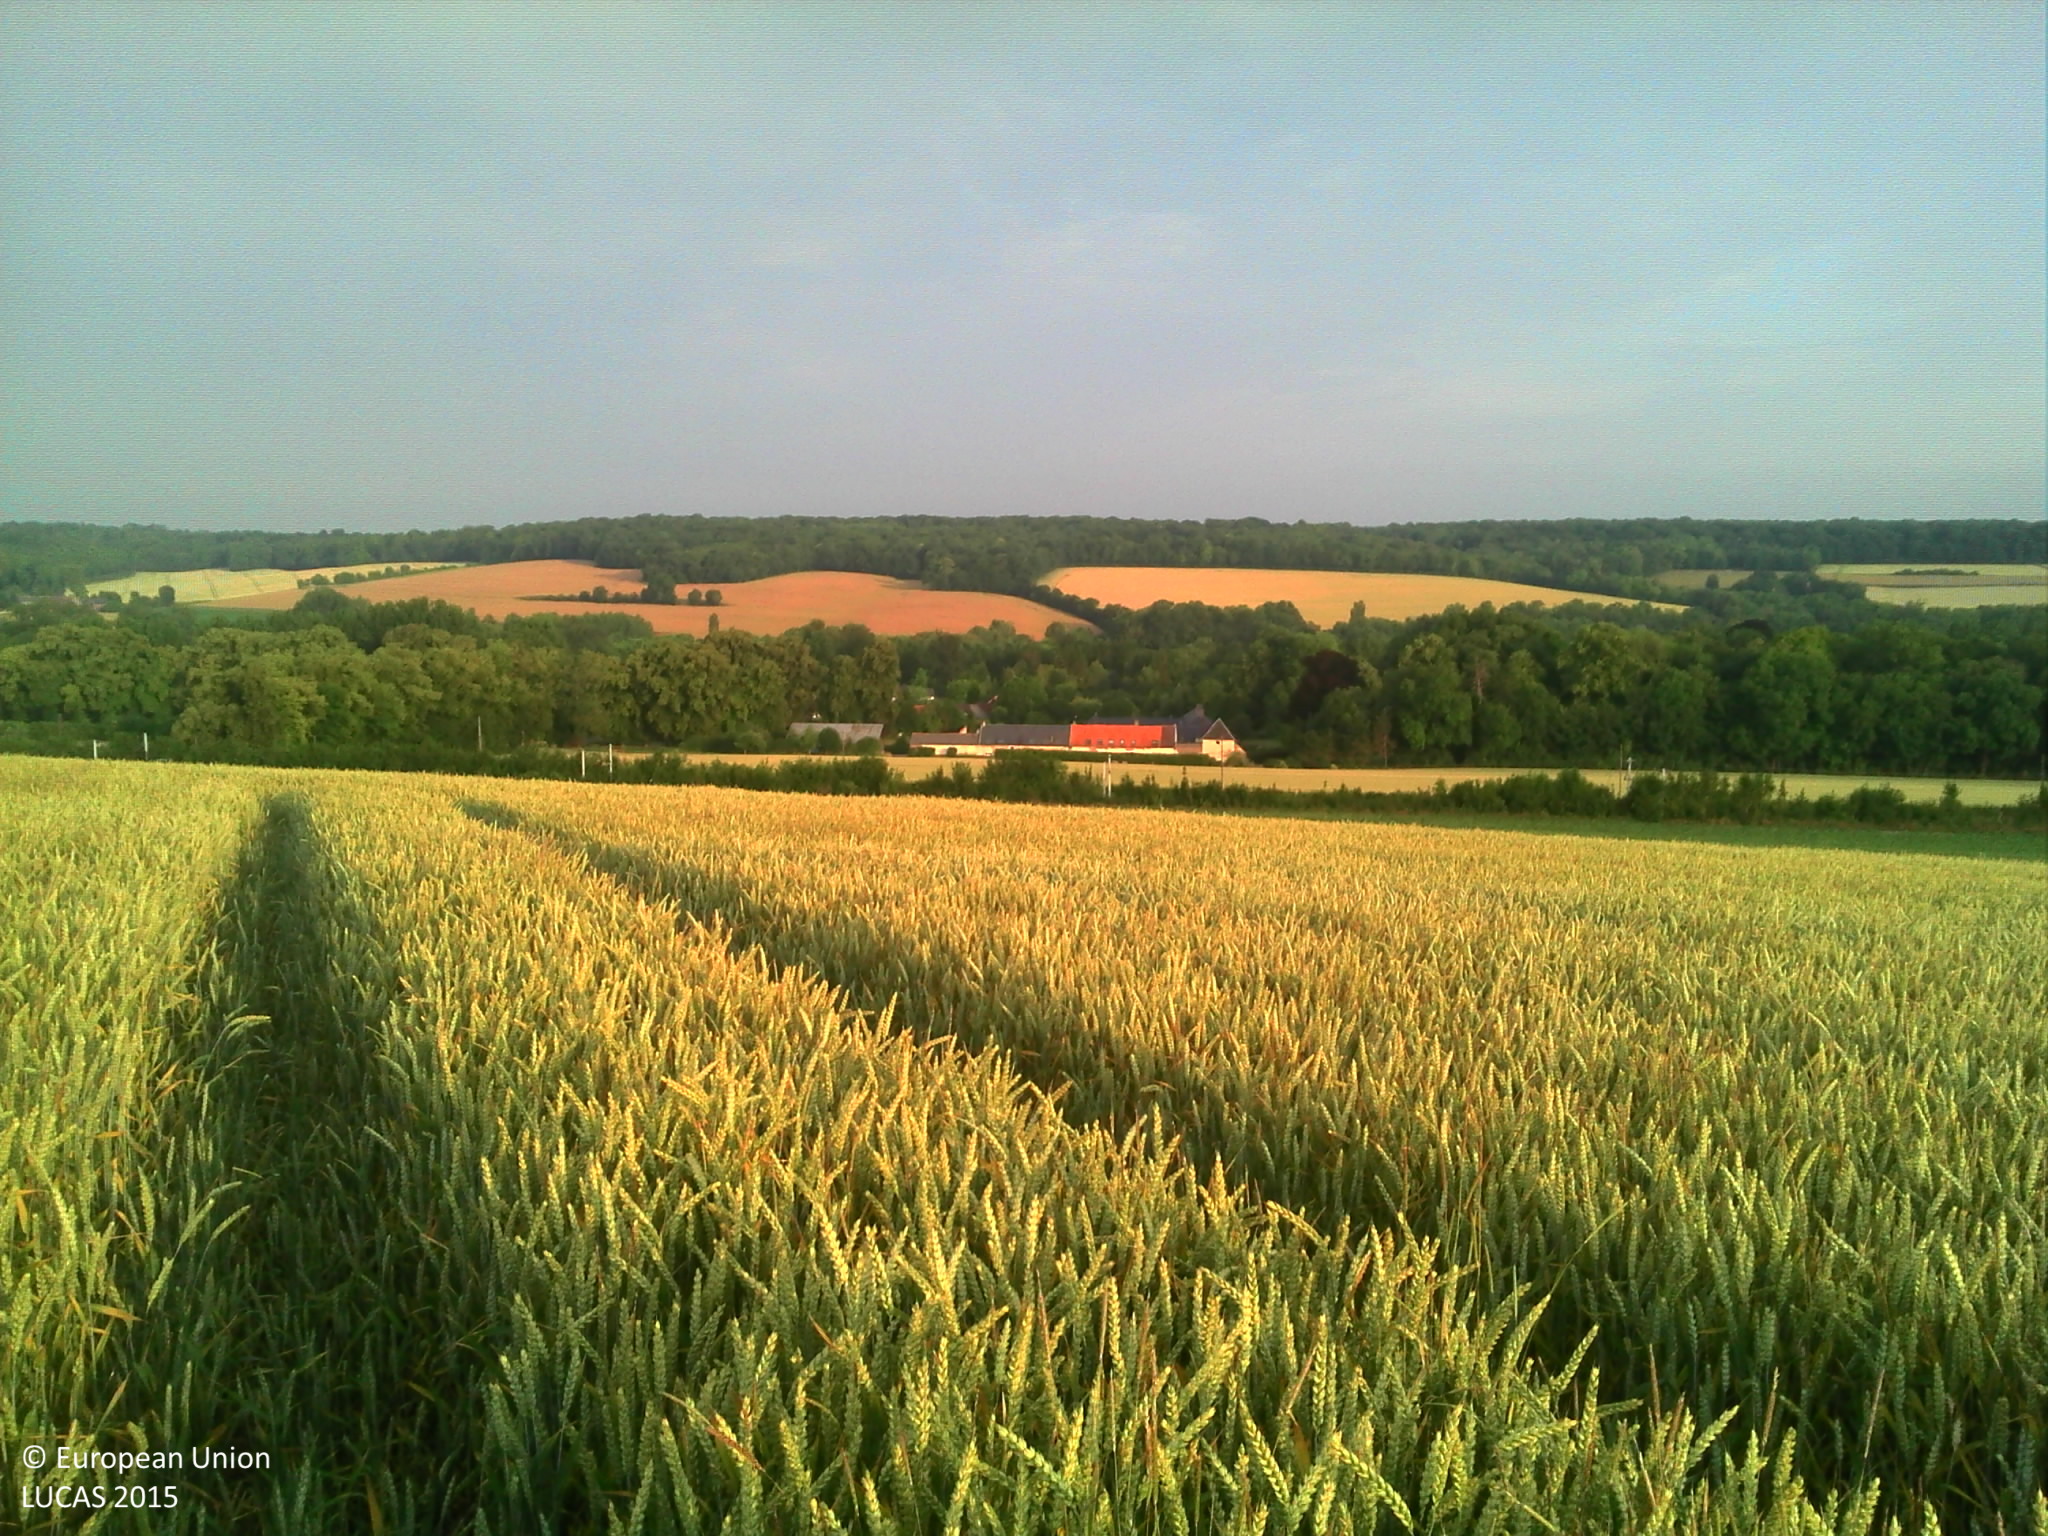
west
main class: Cropland
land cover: Common wheat
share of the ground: > 75 %
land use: Agriculture (excluding fallow land and kitchen gardens)
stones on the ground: 10 - 25 %
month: July
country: FR
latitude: 49.7852
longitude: 2.3898
